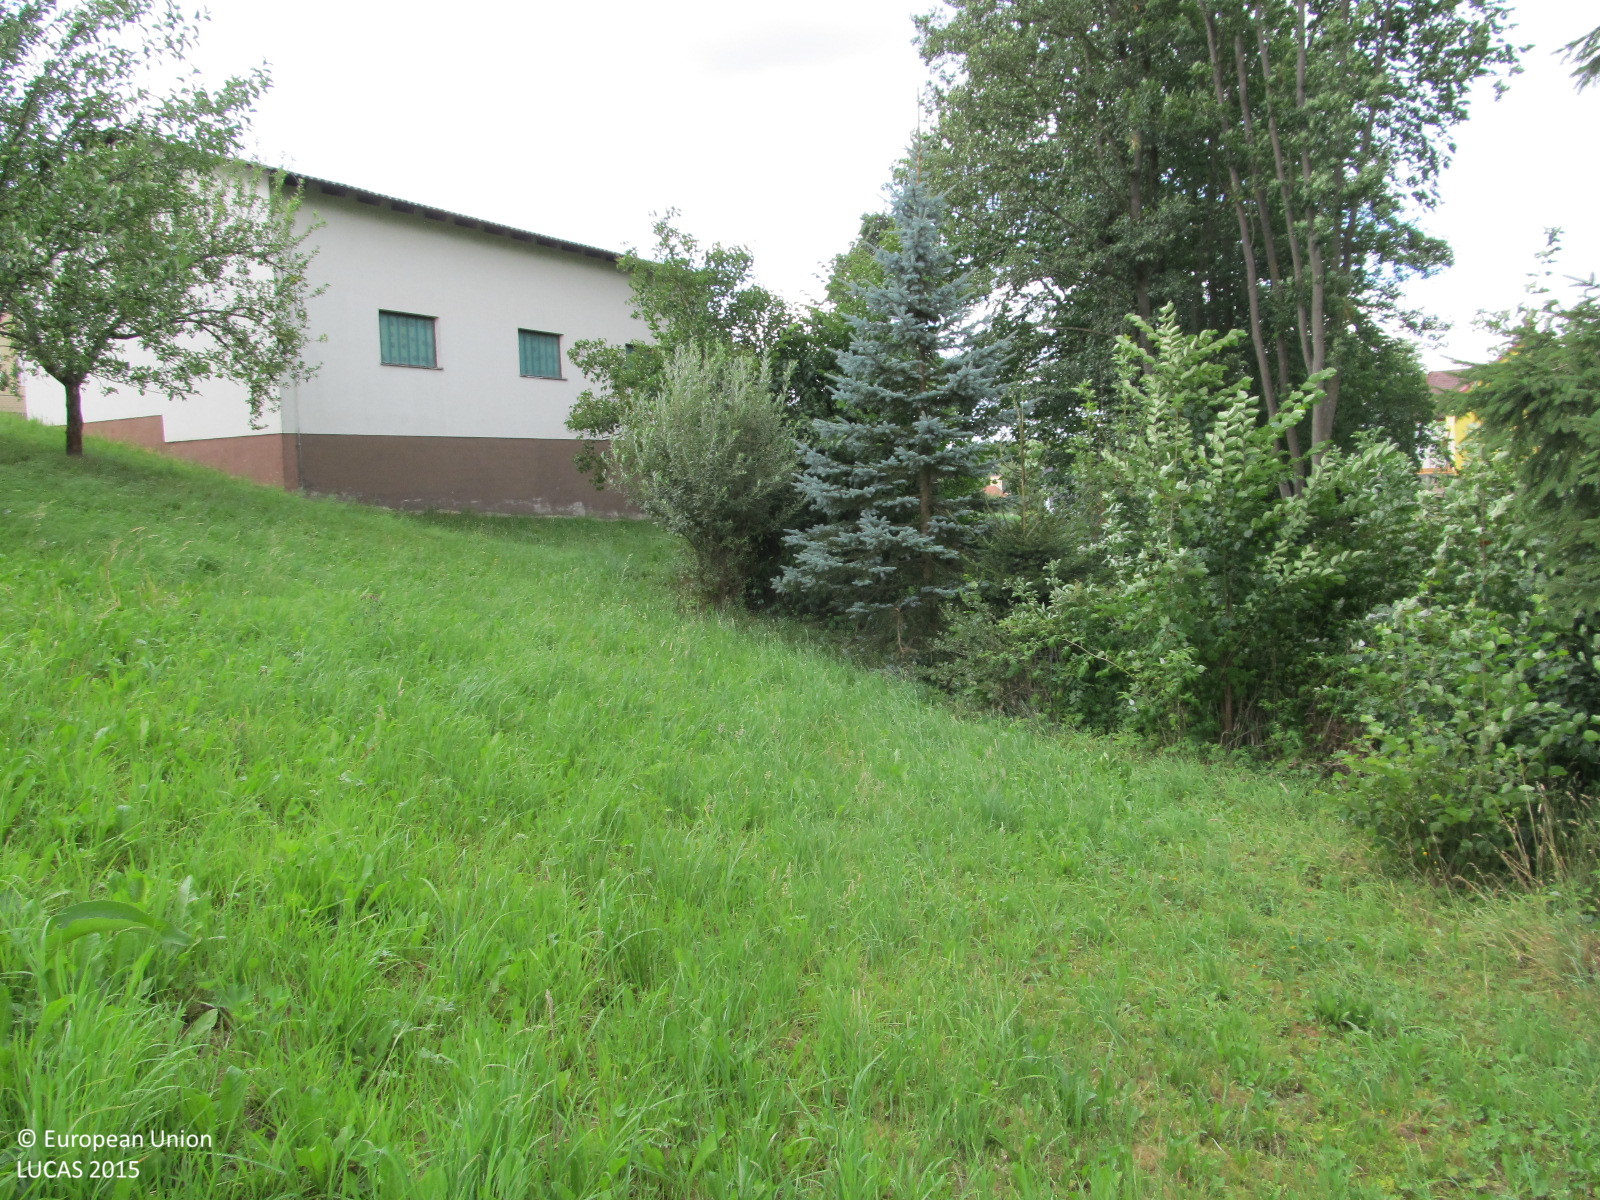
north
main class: Grassland
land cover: Grassland with sparse tree/shrub cover
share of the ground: > 75 %
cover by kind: herbaceous plants 85 %, shrubs 10 %, coniferous forest trees 5 %
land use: Agriculture (excluding fallow land and kitchen gardens)
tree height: < 5 m
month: July
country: AT
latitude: 48.6647
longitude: 15.0937
